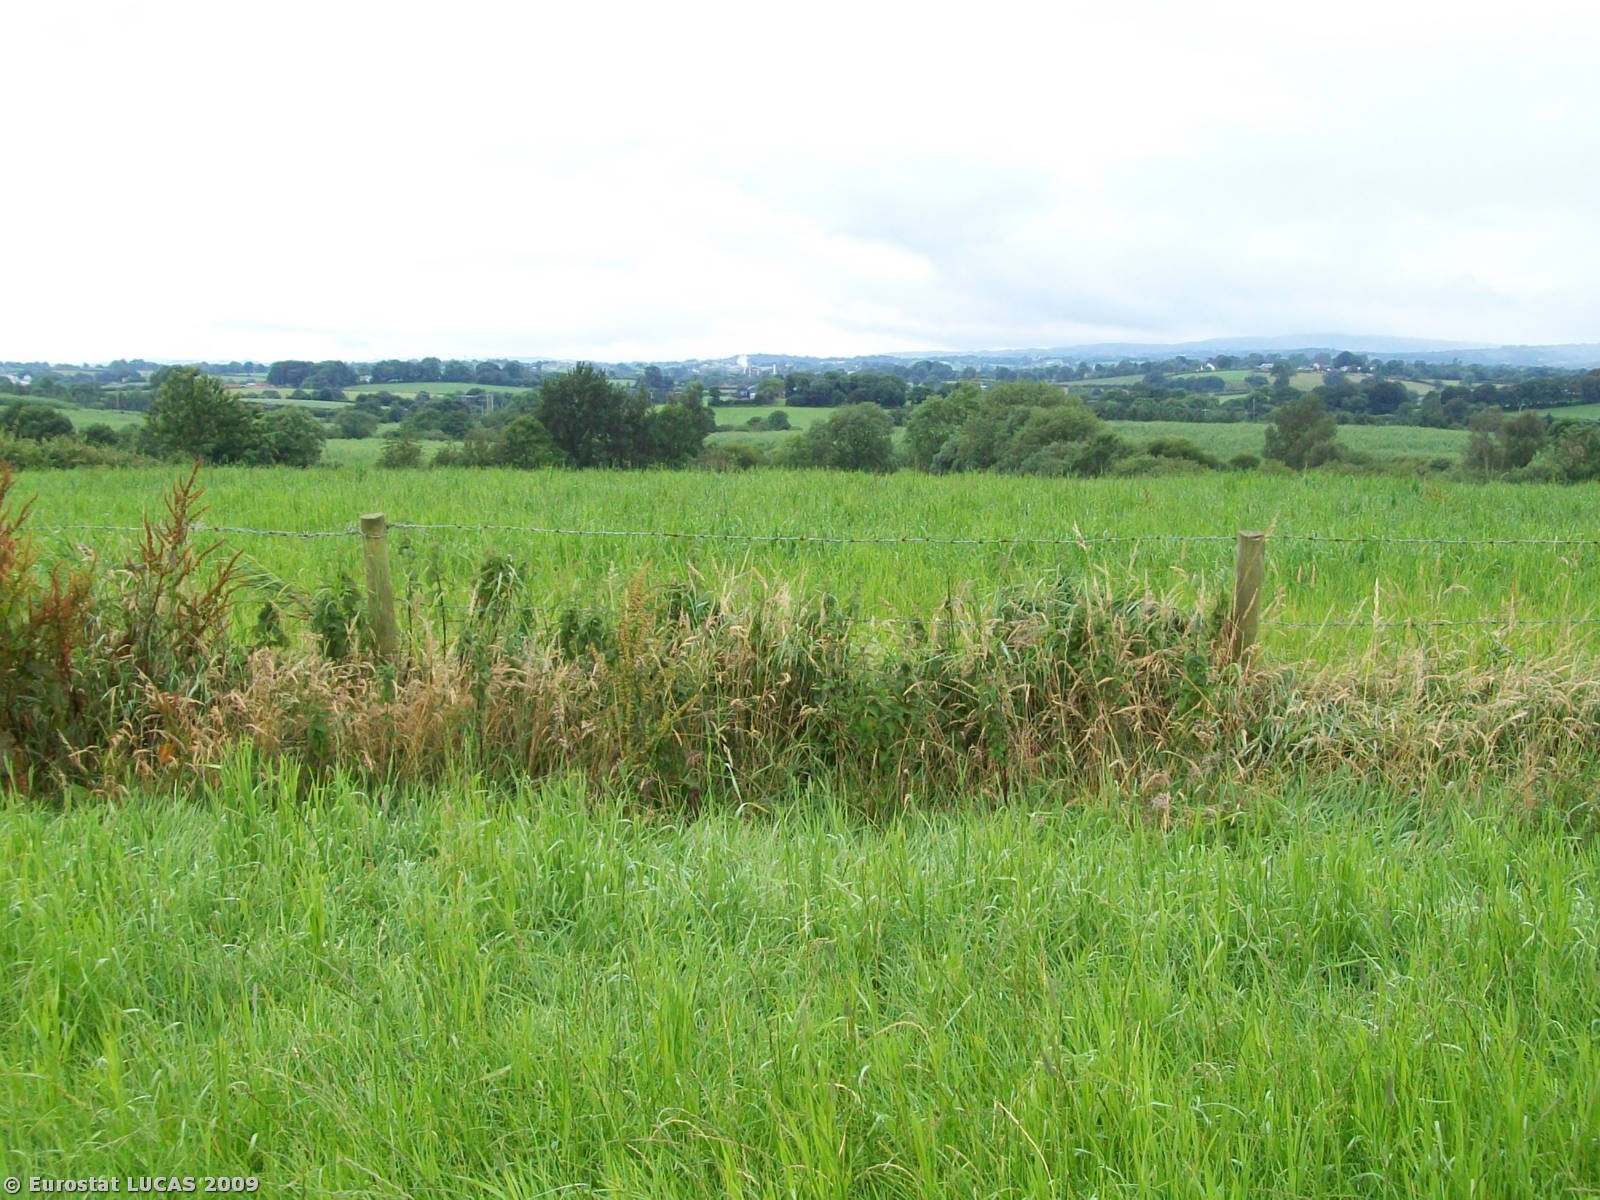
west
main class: Grassland
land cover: Grassland without tree/shrub cover
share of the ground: > 75 %
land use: Agriculture (excluding fallow land and kitchen gardens)
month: July
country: GB
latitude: 54.6621
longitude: -6.6704
